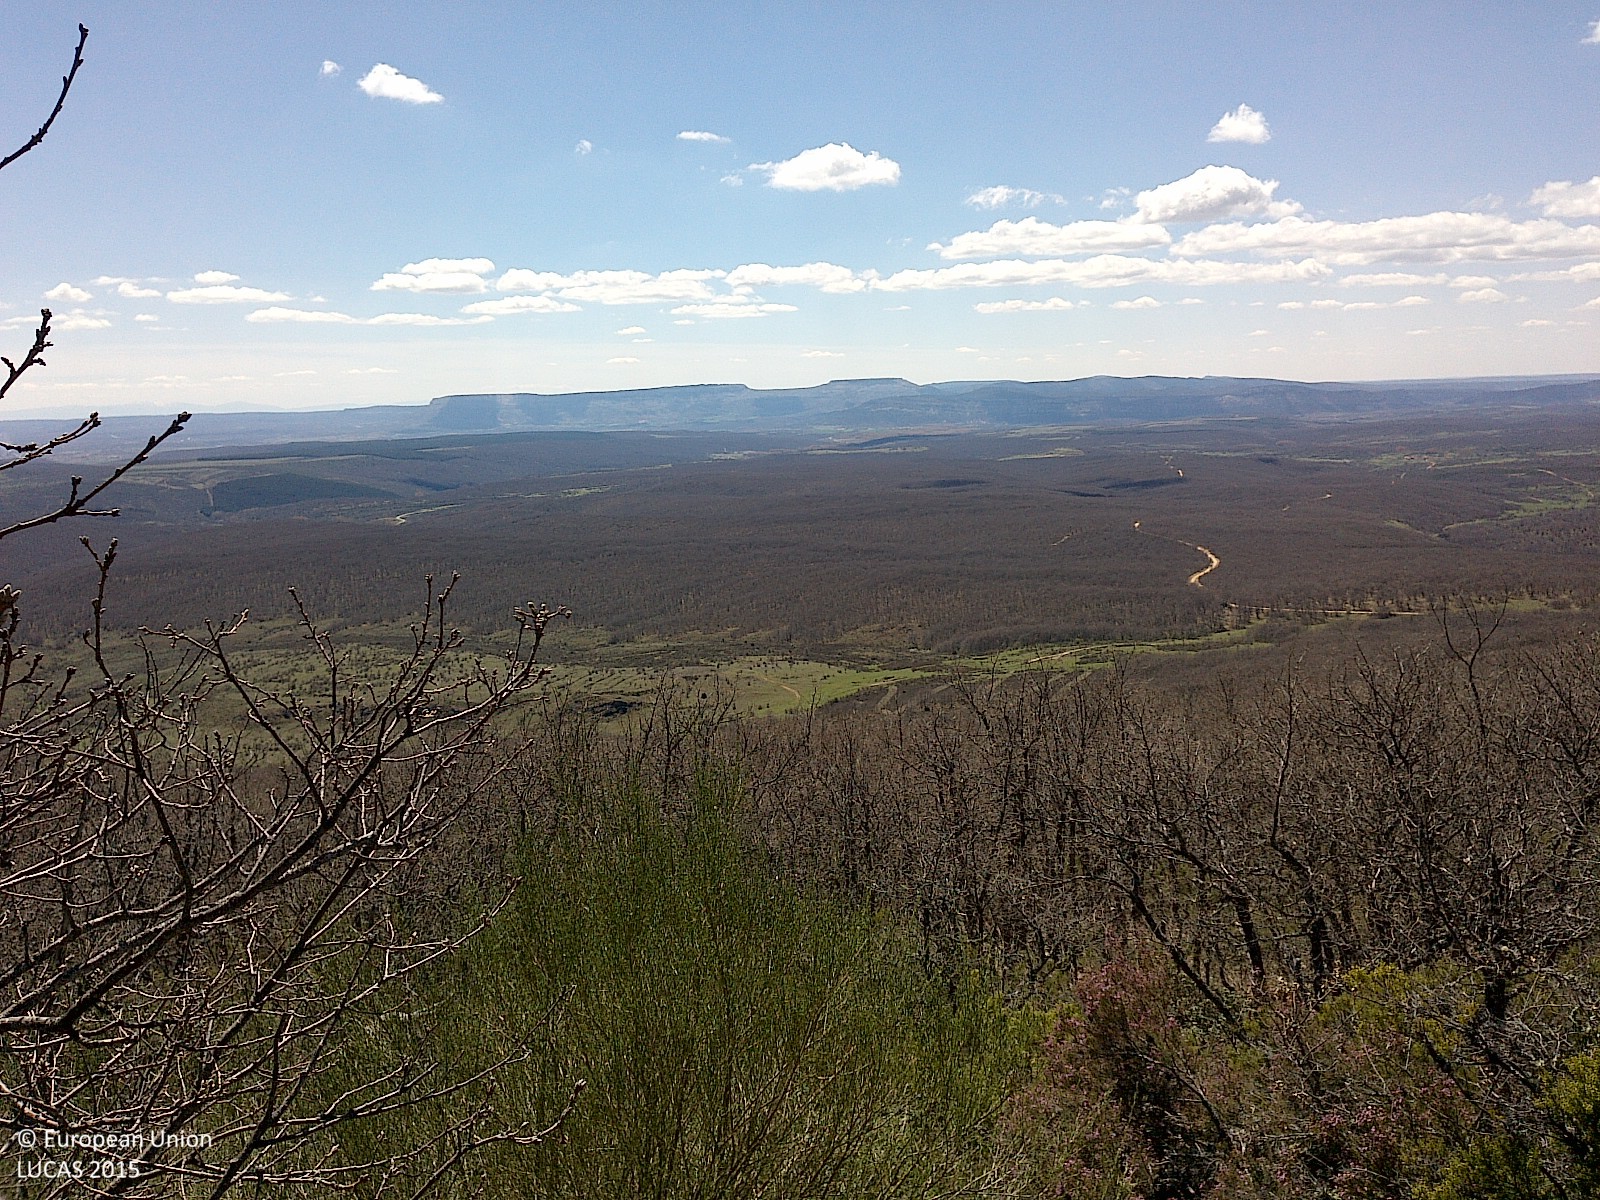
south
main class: Woodland
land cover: Broadleaved woodland
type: thermophilous deciduous forest
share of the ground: 10 - 25 %
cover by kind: shrubs 65 %, broadleaved forest trees 20 %, consolidated bare surface 10 %, herbaceous plants 5 %
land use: Semi-natural and natural areas not in use
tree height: < 5 m
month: April
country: ES
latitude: 42.1444
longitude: -3.2532
